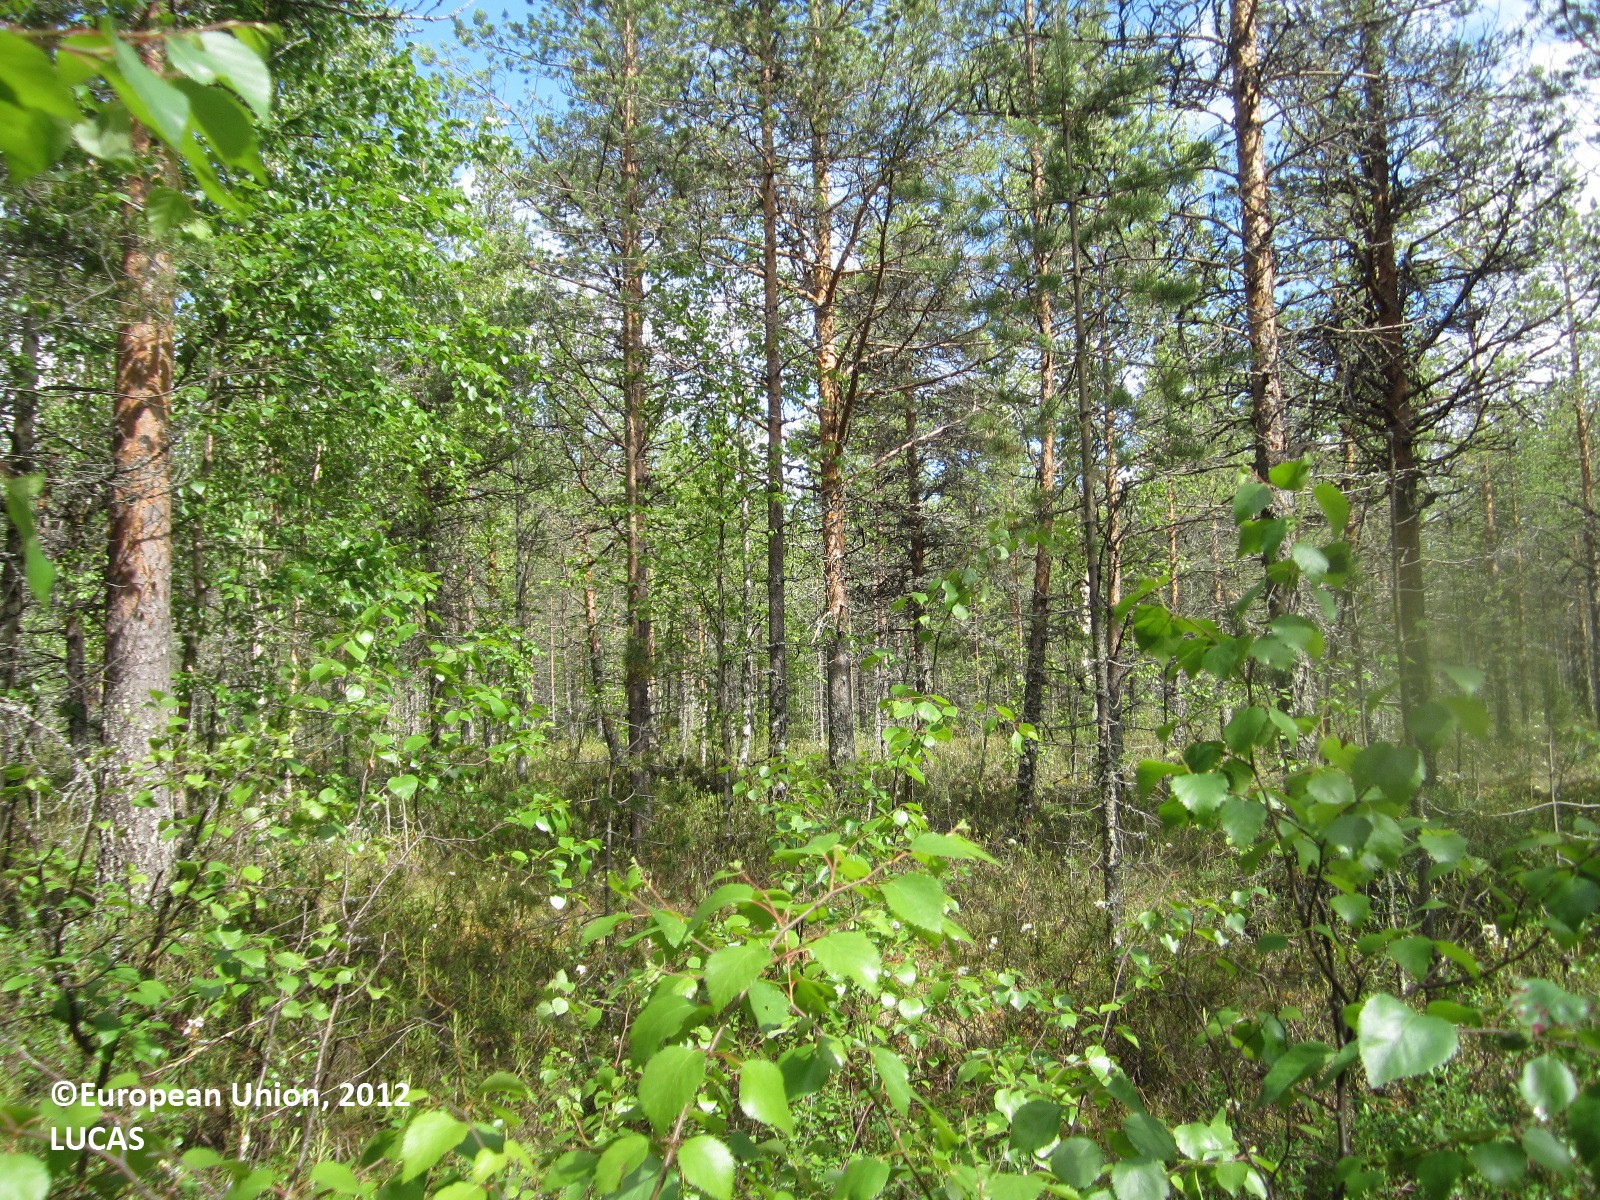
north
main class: Woodland
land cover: Pine dominated mixed woodland
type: boreal forest
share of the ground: 50 - 75 %
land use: Forestry
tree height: > 5 m
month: June
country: FI
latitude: 64.3885
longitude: 29.7785
